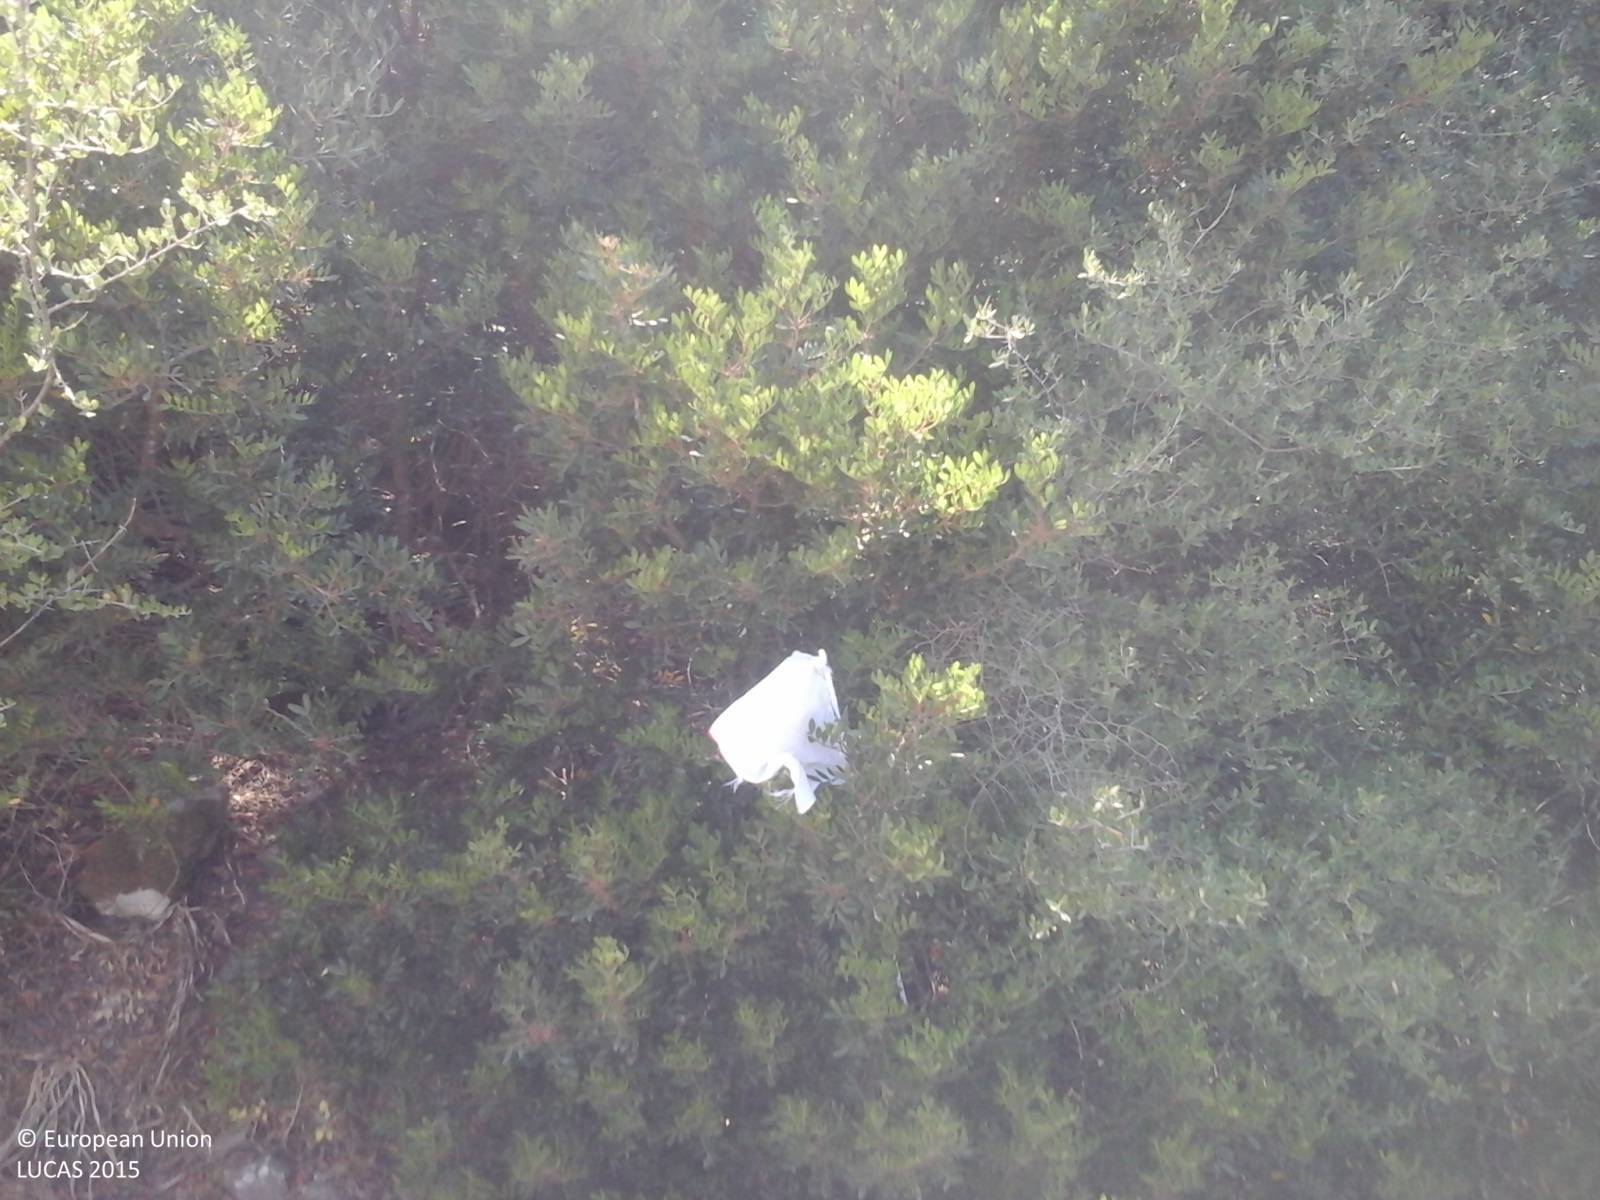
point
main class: Shrubland
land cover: Shrubland without tree cover
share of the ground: > 75 %
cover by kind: shrubs 55 %, unconsolidated bare surface 30 %, herbaceous plants 15 %
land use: Semi-natural and natural areas not in use
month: July
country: IT
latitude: 39.1521
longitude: 8.5856
